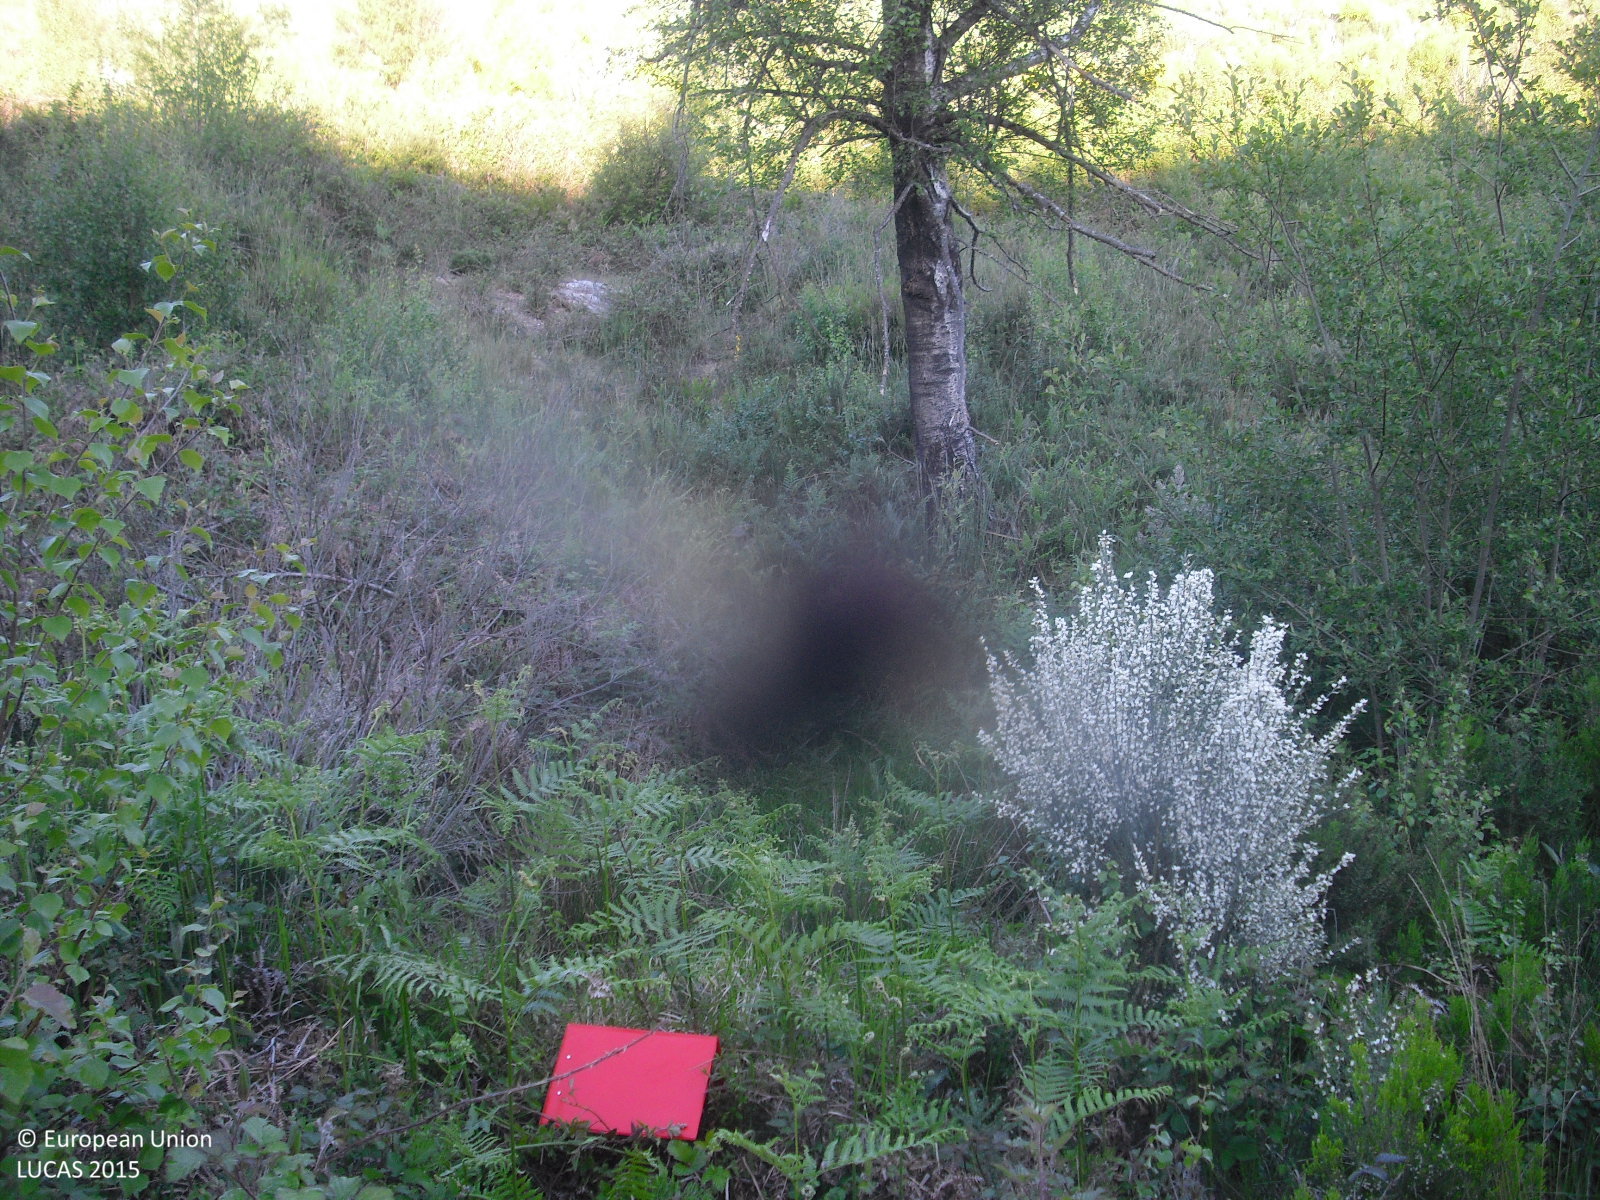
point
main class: Shrubland
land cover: Shrubland with sparse tree cover
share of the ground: > 75 %
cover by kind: shrubs 80 %, herbaceous plants 15 %, broadleaved forest trees 5 %
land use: Forestry
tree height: < 5 m
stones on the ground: 25 - 50 %
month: May
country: ES
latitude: 42.0249
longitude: -7.3663
